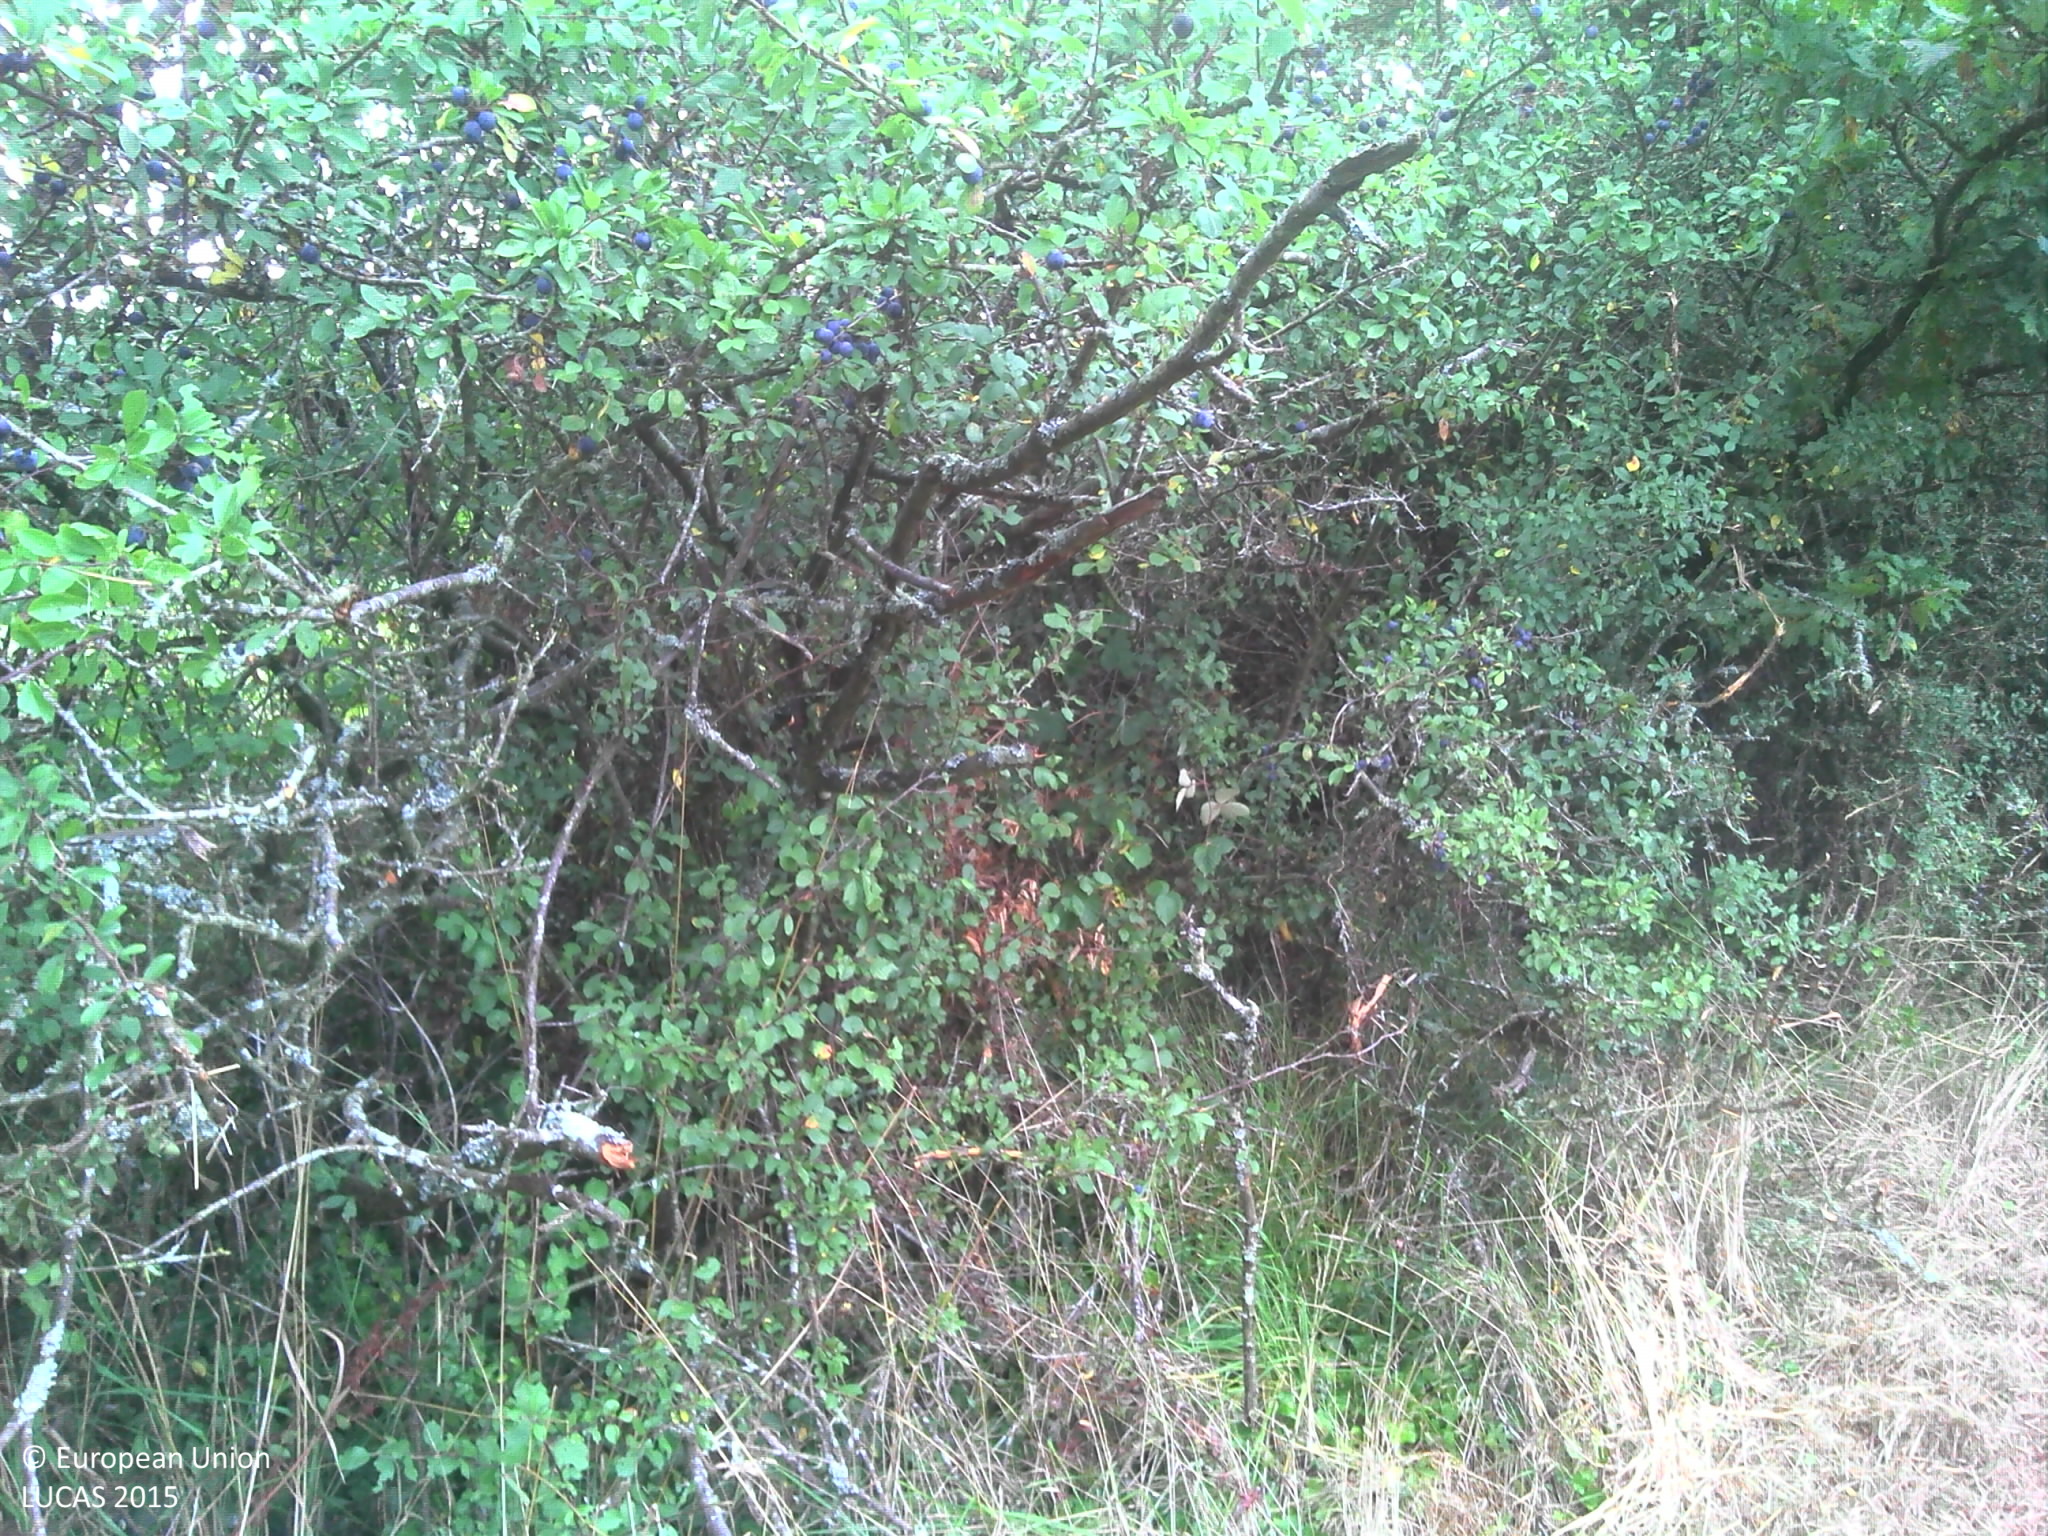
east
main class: Grassland
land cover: Grassland without tree/shrub cover
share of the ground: > 75 %
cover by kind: herbaceous plants 100 %
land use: Agriculture (excluding fallow land and kitchen gardens)
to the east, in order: Abandoned hedges; Fences; Ditches and canals; Fences; Grassland without tree/shrub cover; Fences; Grassland without tree/shrub cover; Fences; Broadleaved woodland; Ditches and canals; Fences; Grassland without tree/shrub cover; Electric lines; Grassland without tree/shrub cover; Fences; Managed hedges; Ditches and canals; Grass margins; Paved roads, cycling and walking lanes; Grass margins; Ditches and canals; Managed hedges; Fences; Grassland without tree/shrub cover
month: August
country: FR
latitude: 46.7104
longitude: -1.6698
